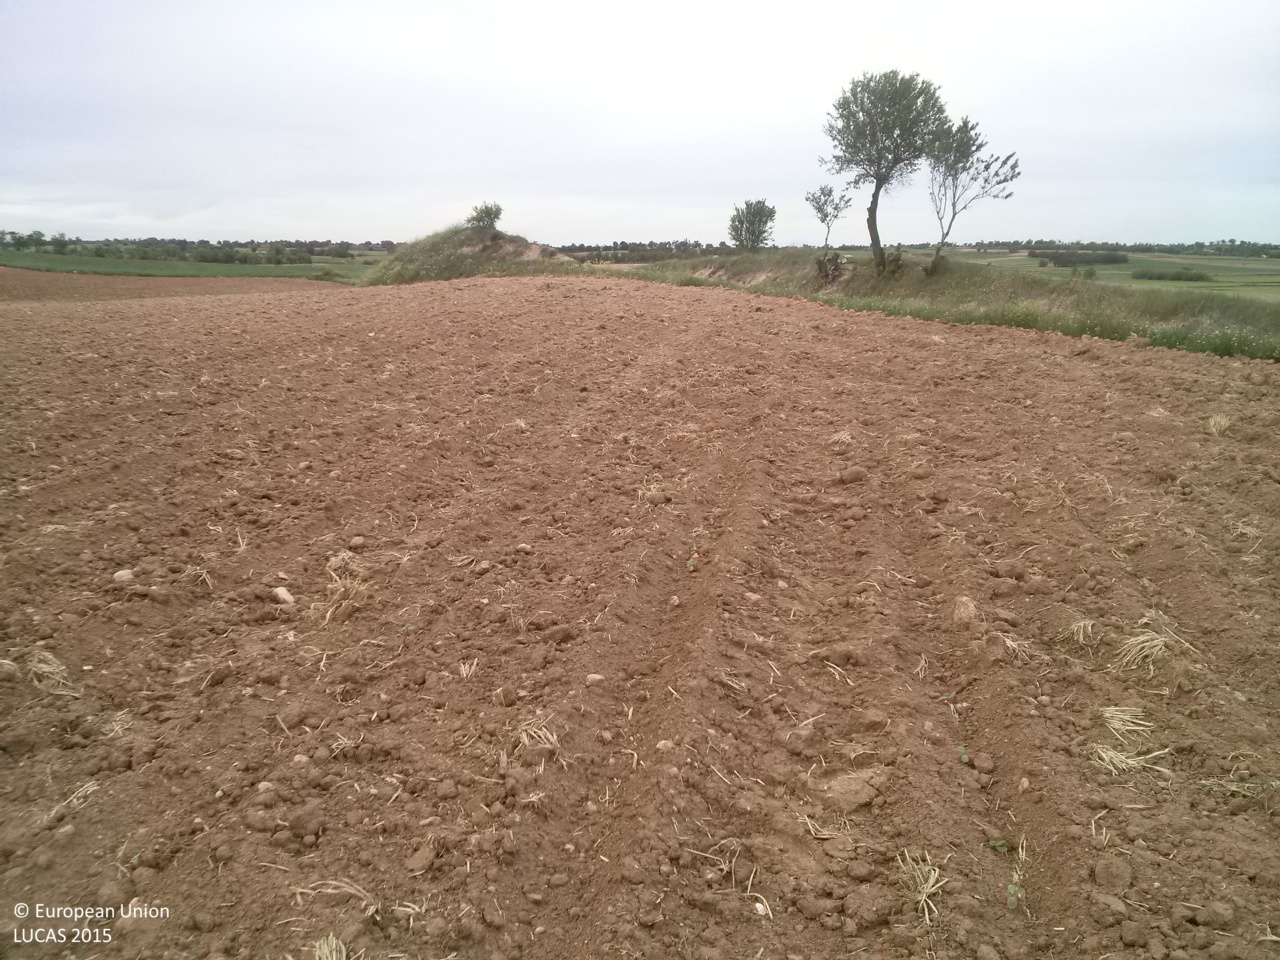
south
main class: Cropland
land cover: Sunflower
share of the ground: < 10 %
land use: Agriculture (excluding fallow land and kitchen gardens)
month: May
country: ES
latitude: 39.9089
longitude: -2.8769
